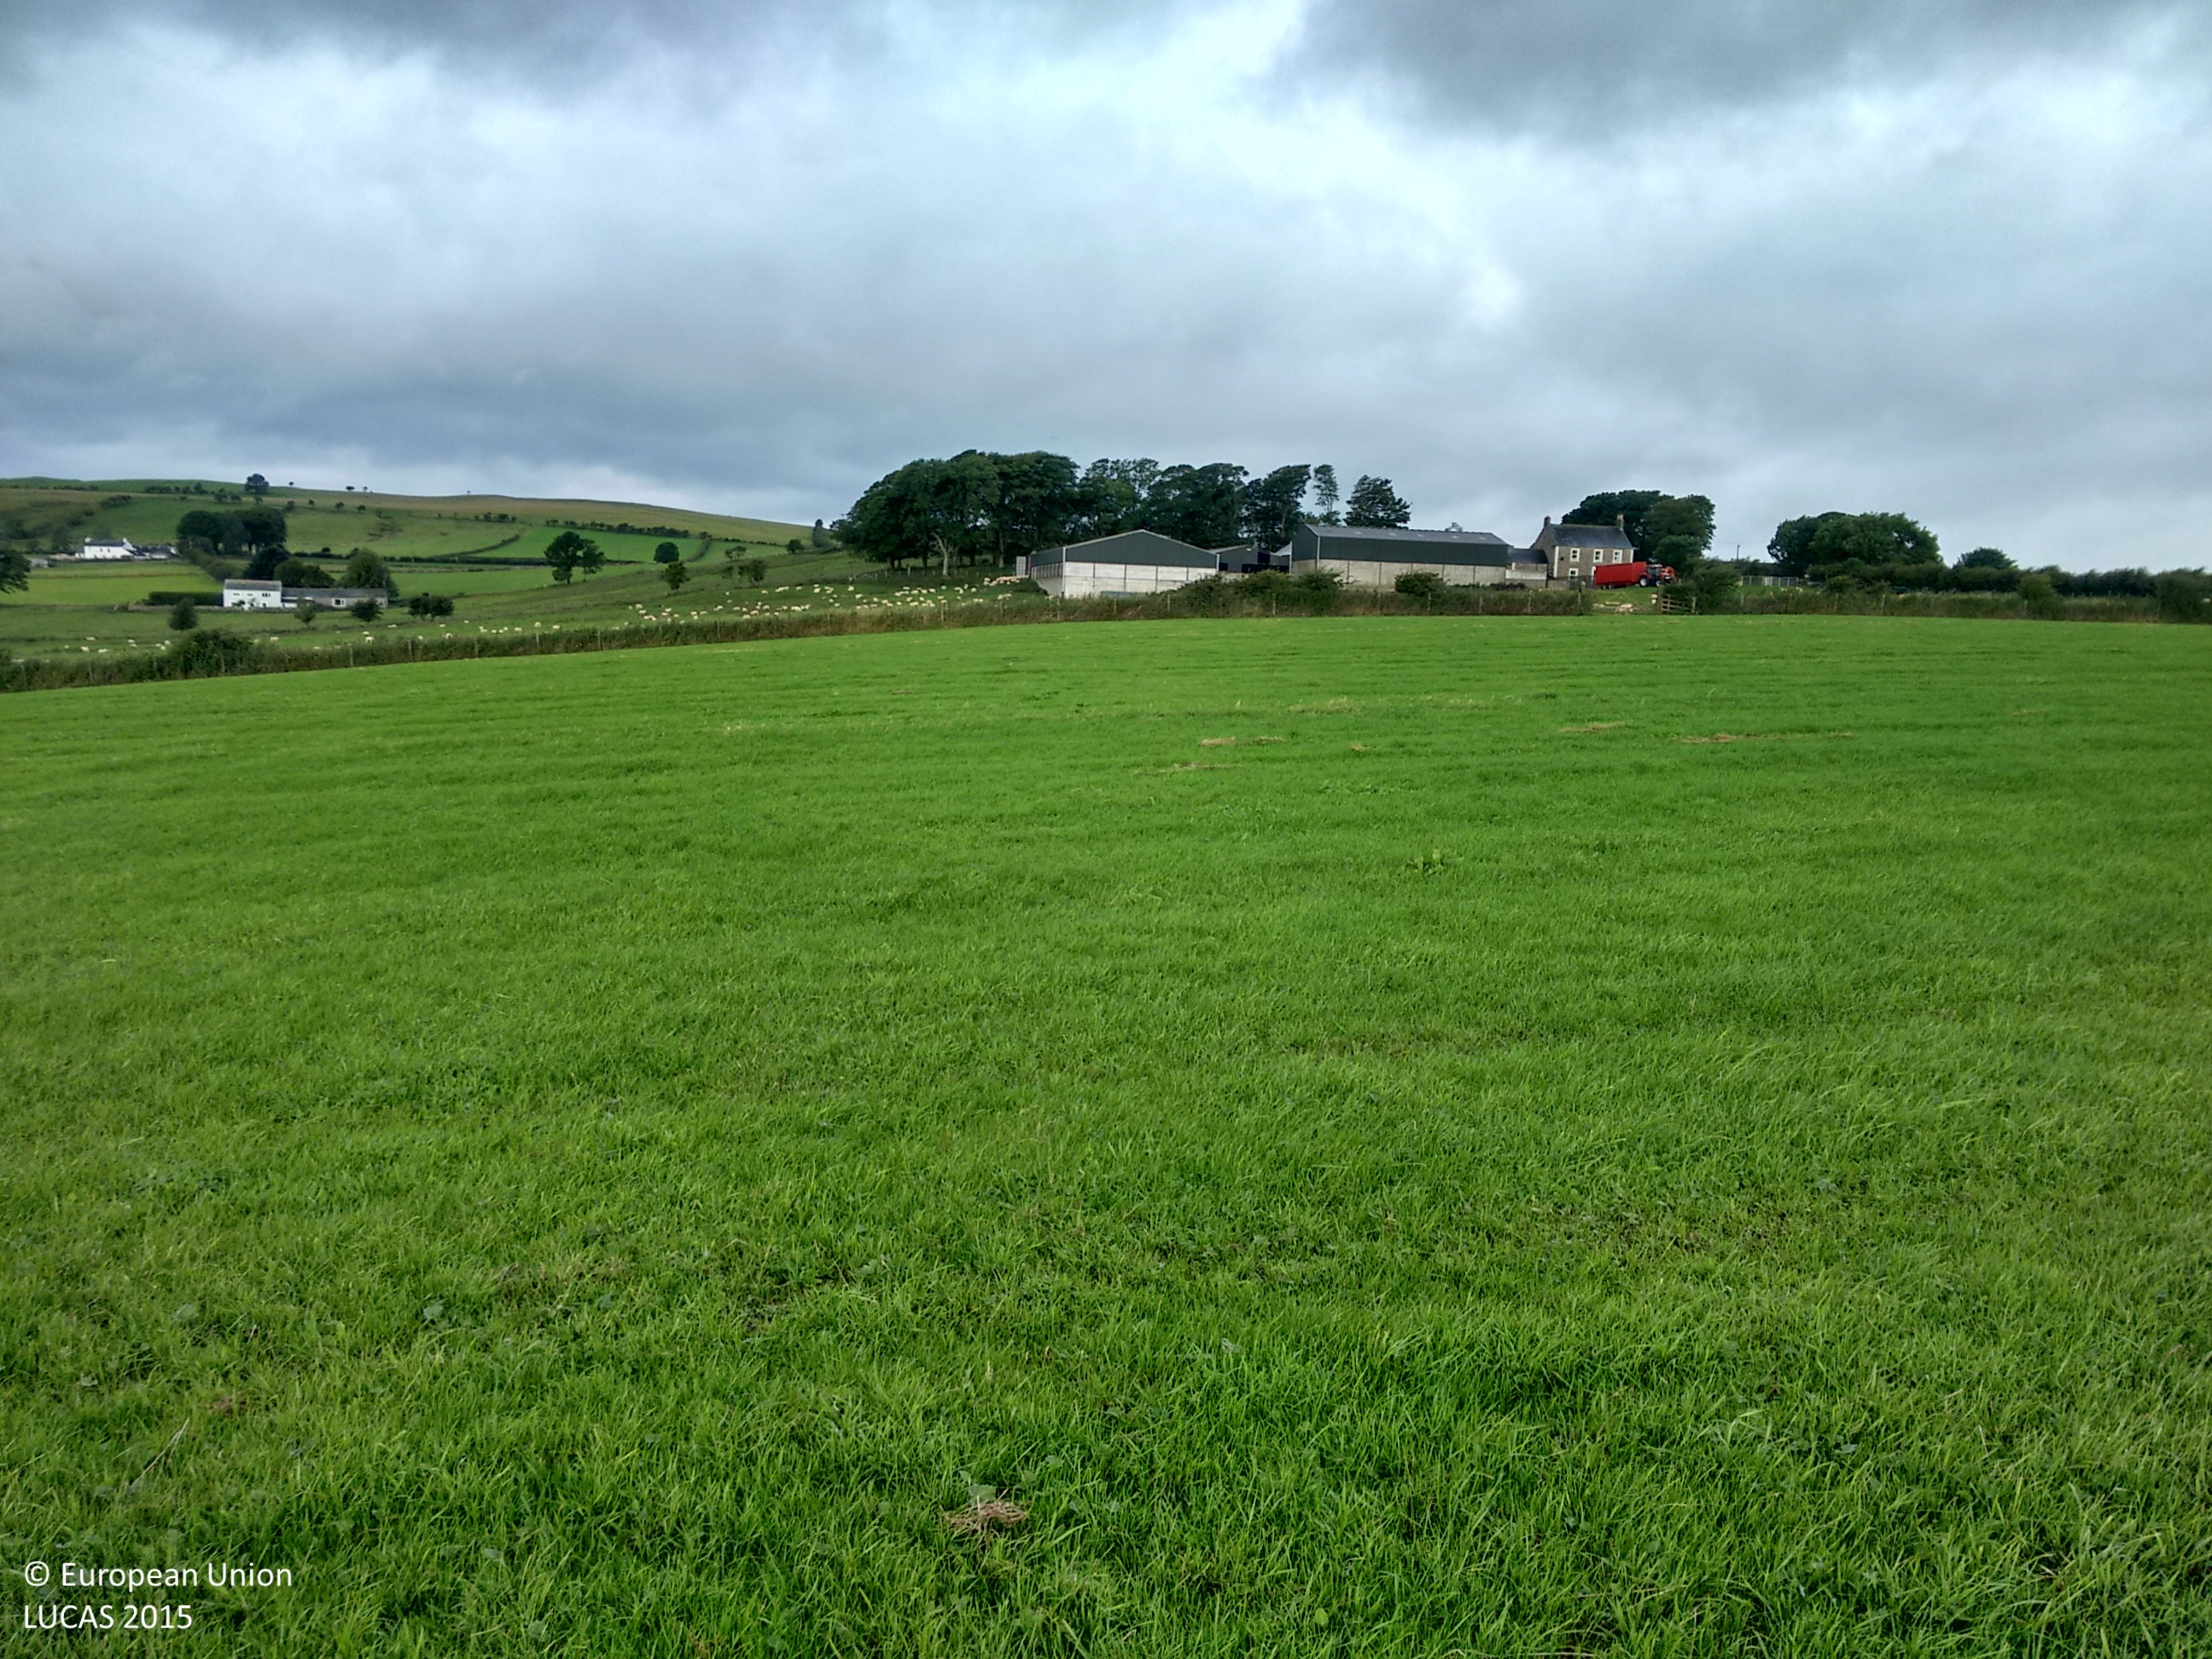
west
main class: Grassland
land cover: Grassland without tree/shrub cover
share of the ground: > 75 %
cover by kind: herbaceous plants 100 %
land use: Agriculture (excluding fallow land and kitchen gardens)
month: August
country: GB
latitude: 54.7325
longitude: -3.2299
